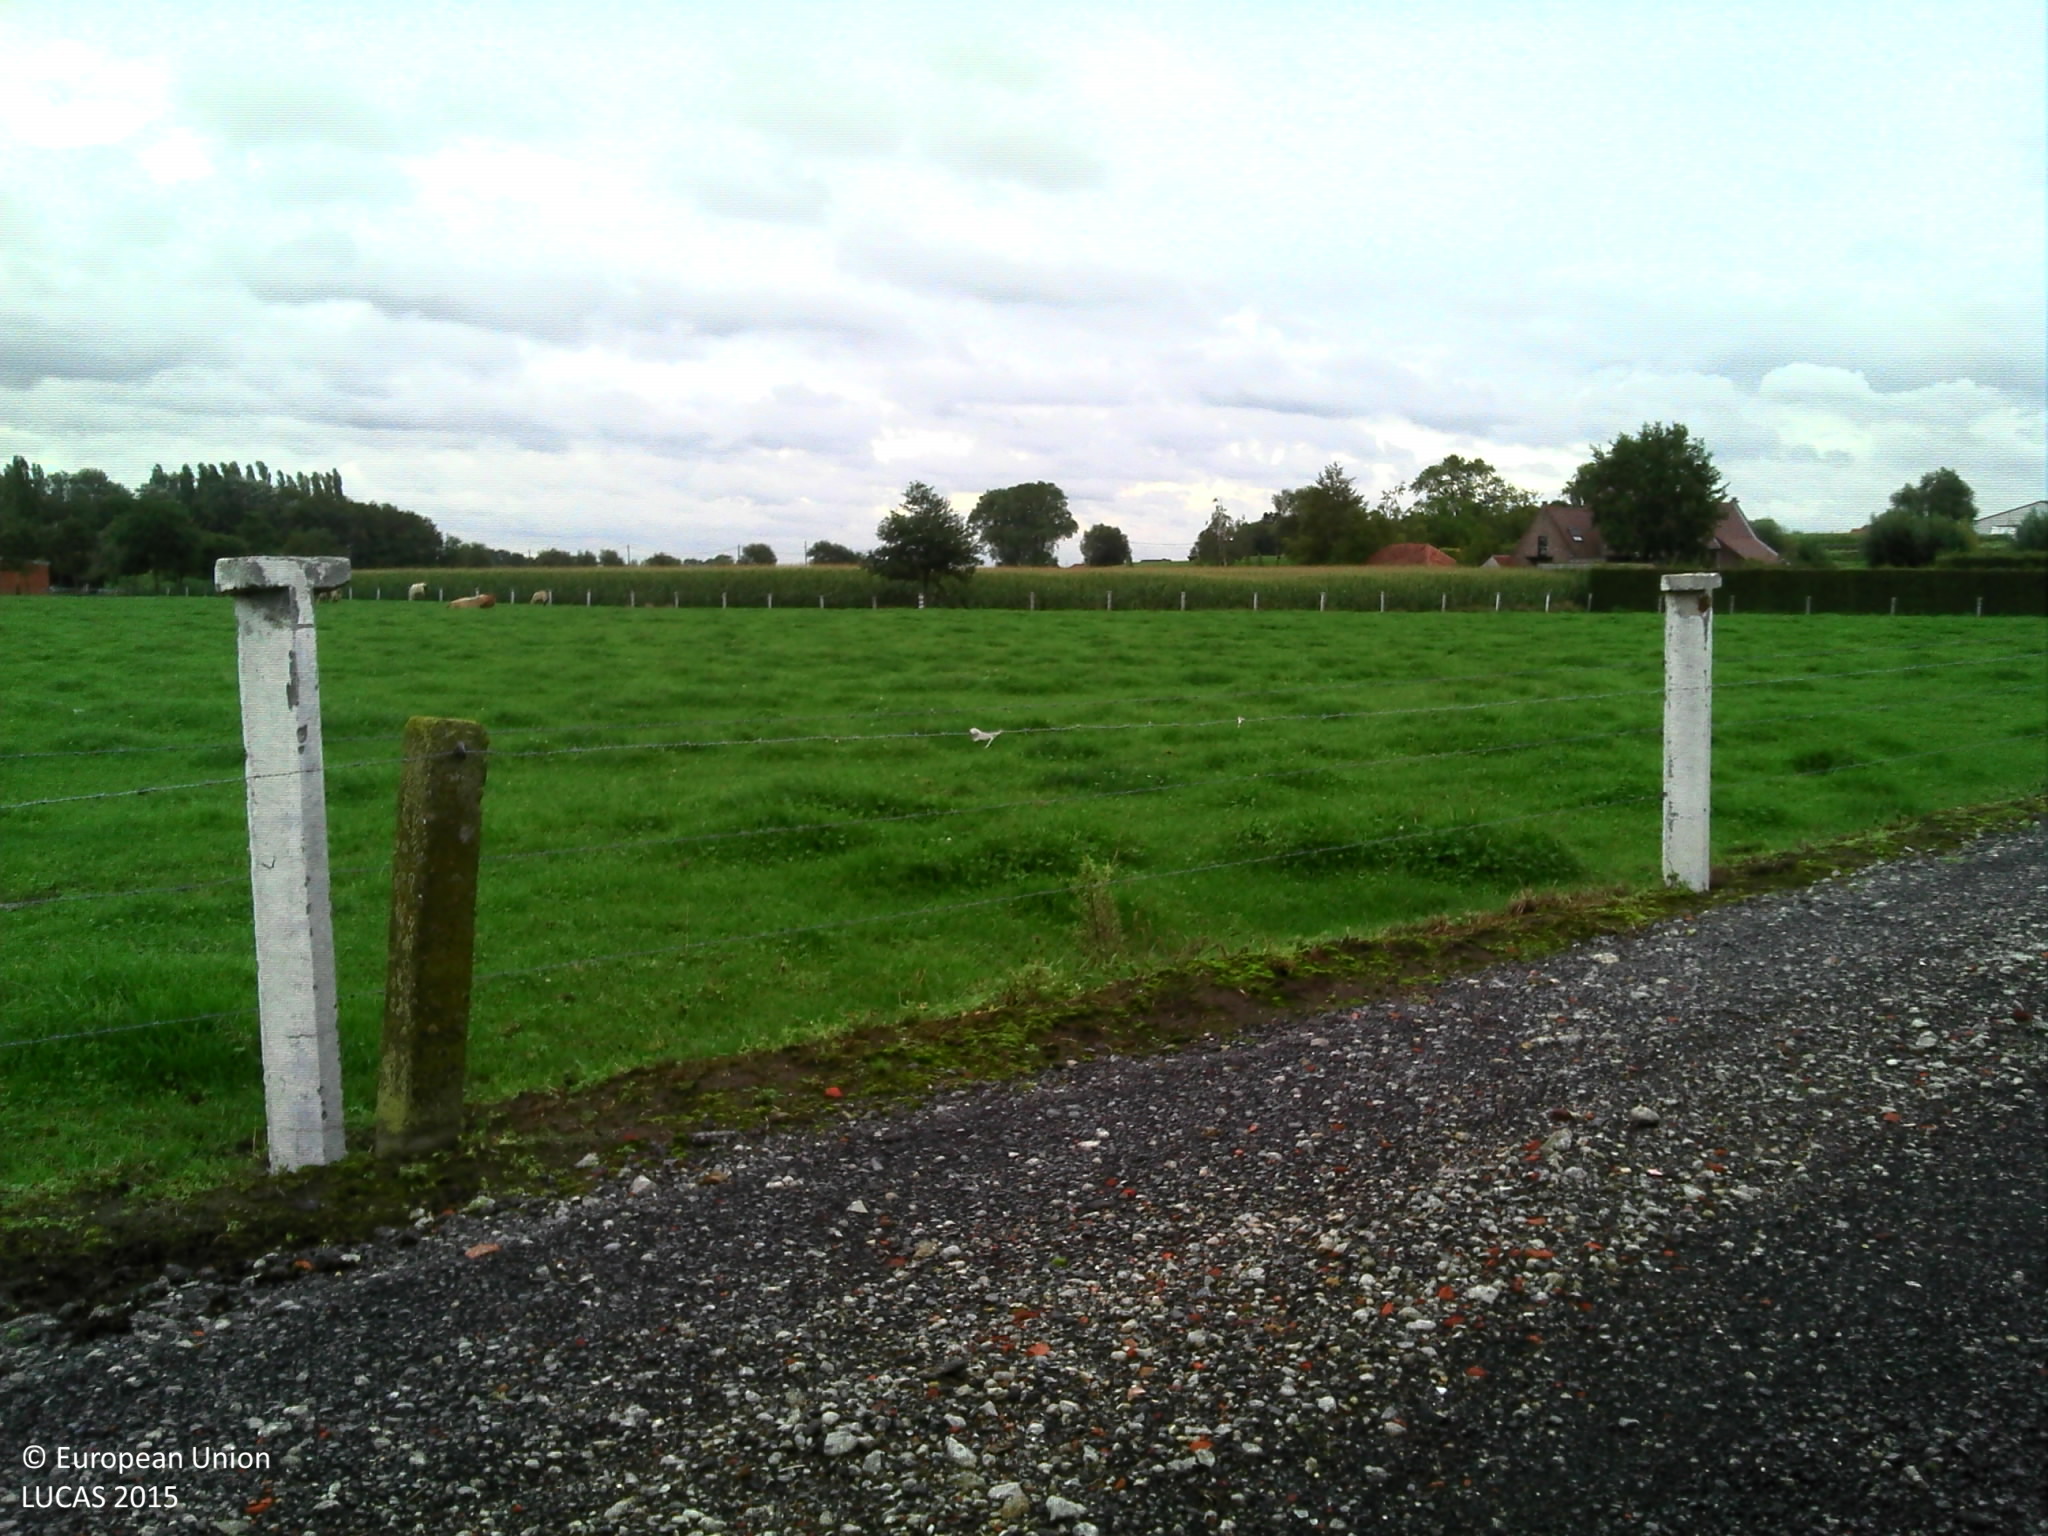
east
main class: Cropland
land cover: Maize
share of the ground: > 75 %
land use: Agriculture (excluding fallow land and kitchen gardens)
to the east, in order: Maize; Tracks; Fences; Grassland without tree/shrub cover; Fences; Maize; Artificial constructions in urban areas; Maize
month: September
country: BE
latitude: 51.1294
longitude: 3.0884
